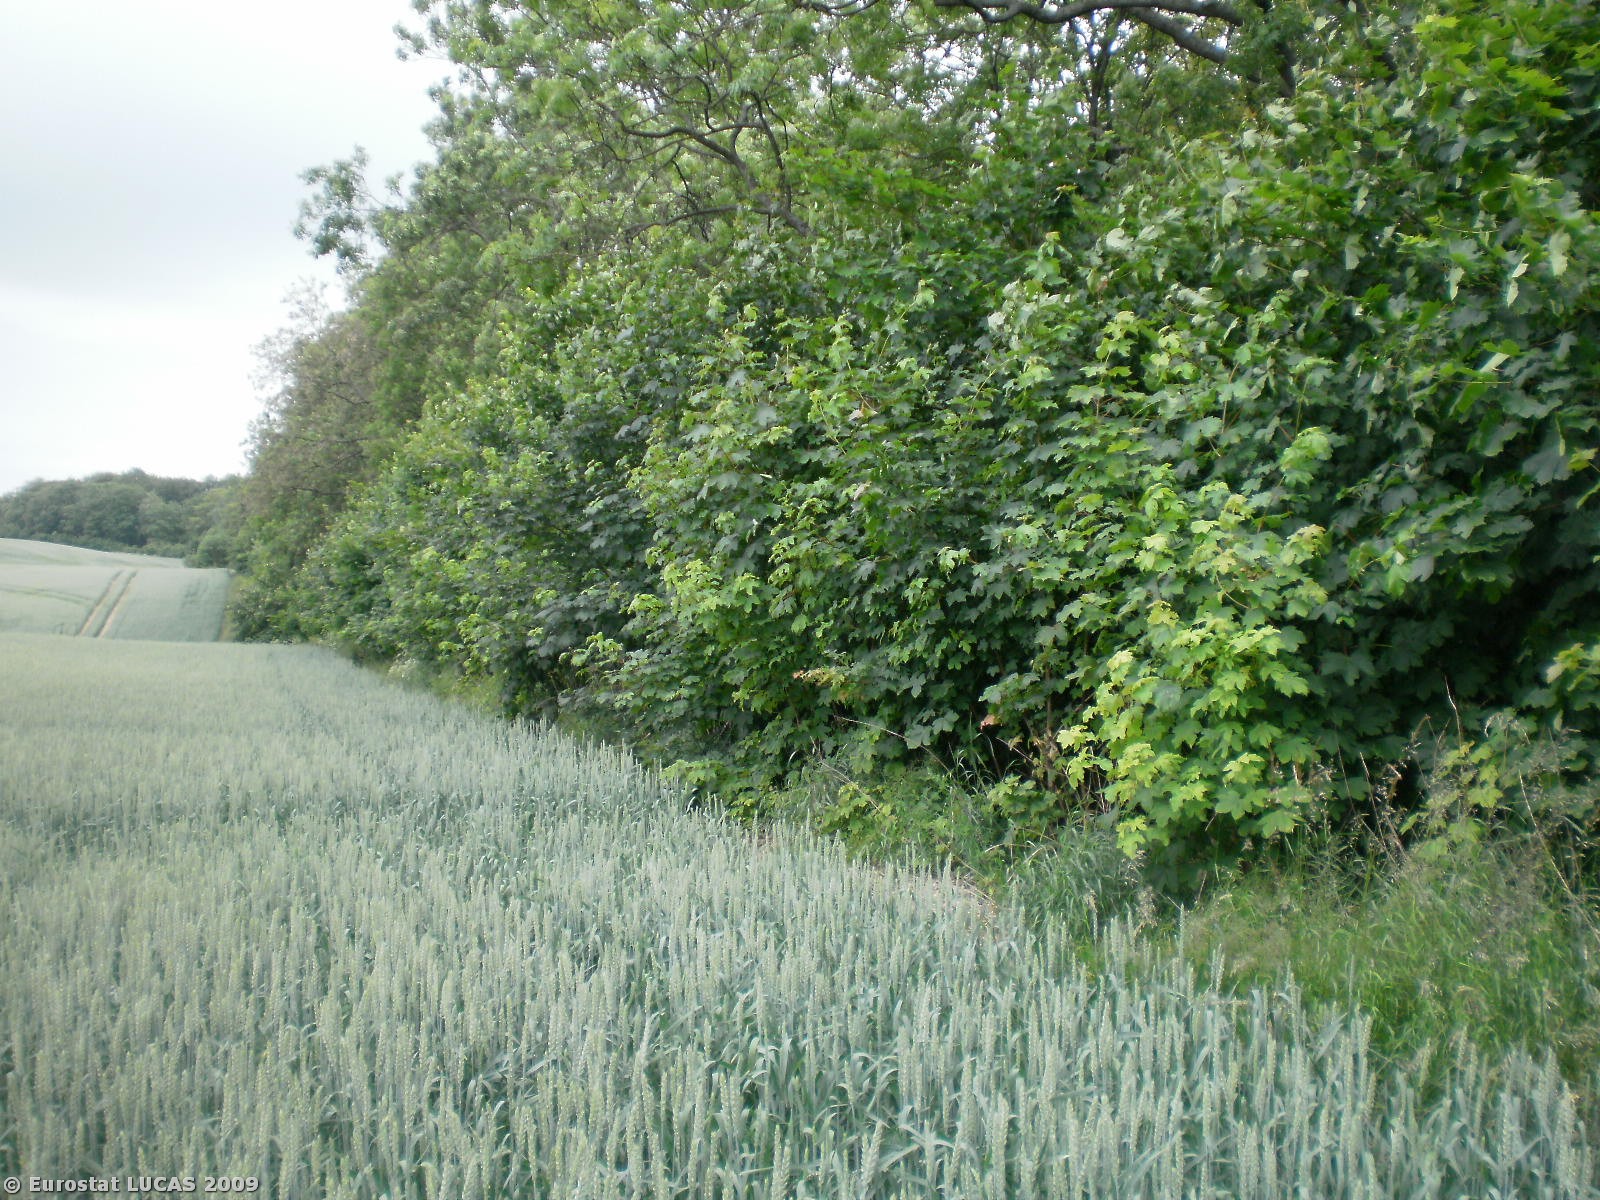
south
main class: Cropland
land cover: Common wheat
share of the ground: > 75 %
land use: Agriculture (excluding fallow land and kitchen gardens)
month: June
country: PL
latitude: 54.7145
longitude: 17.9137
